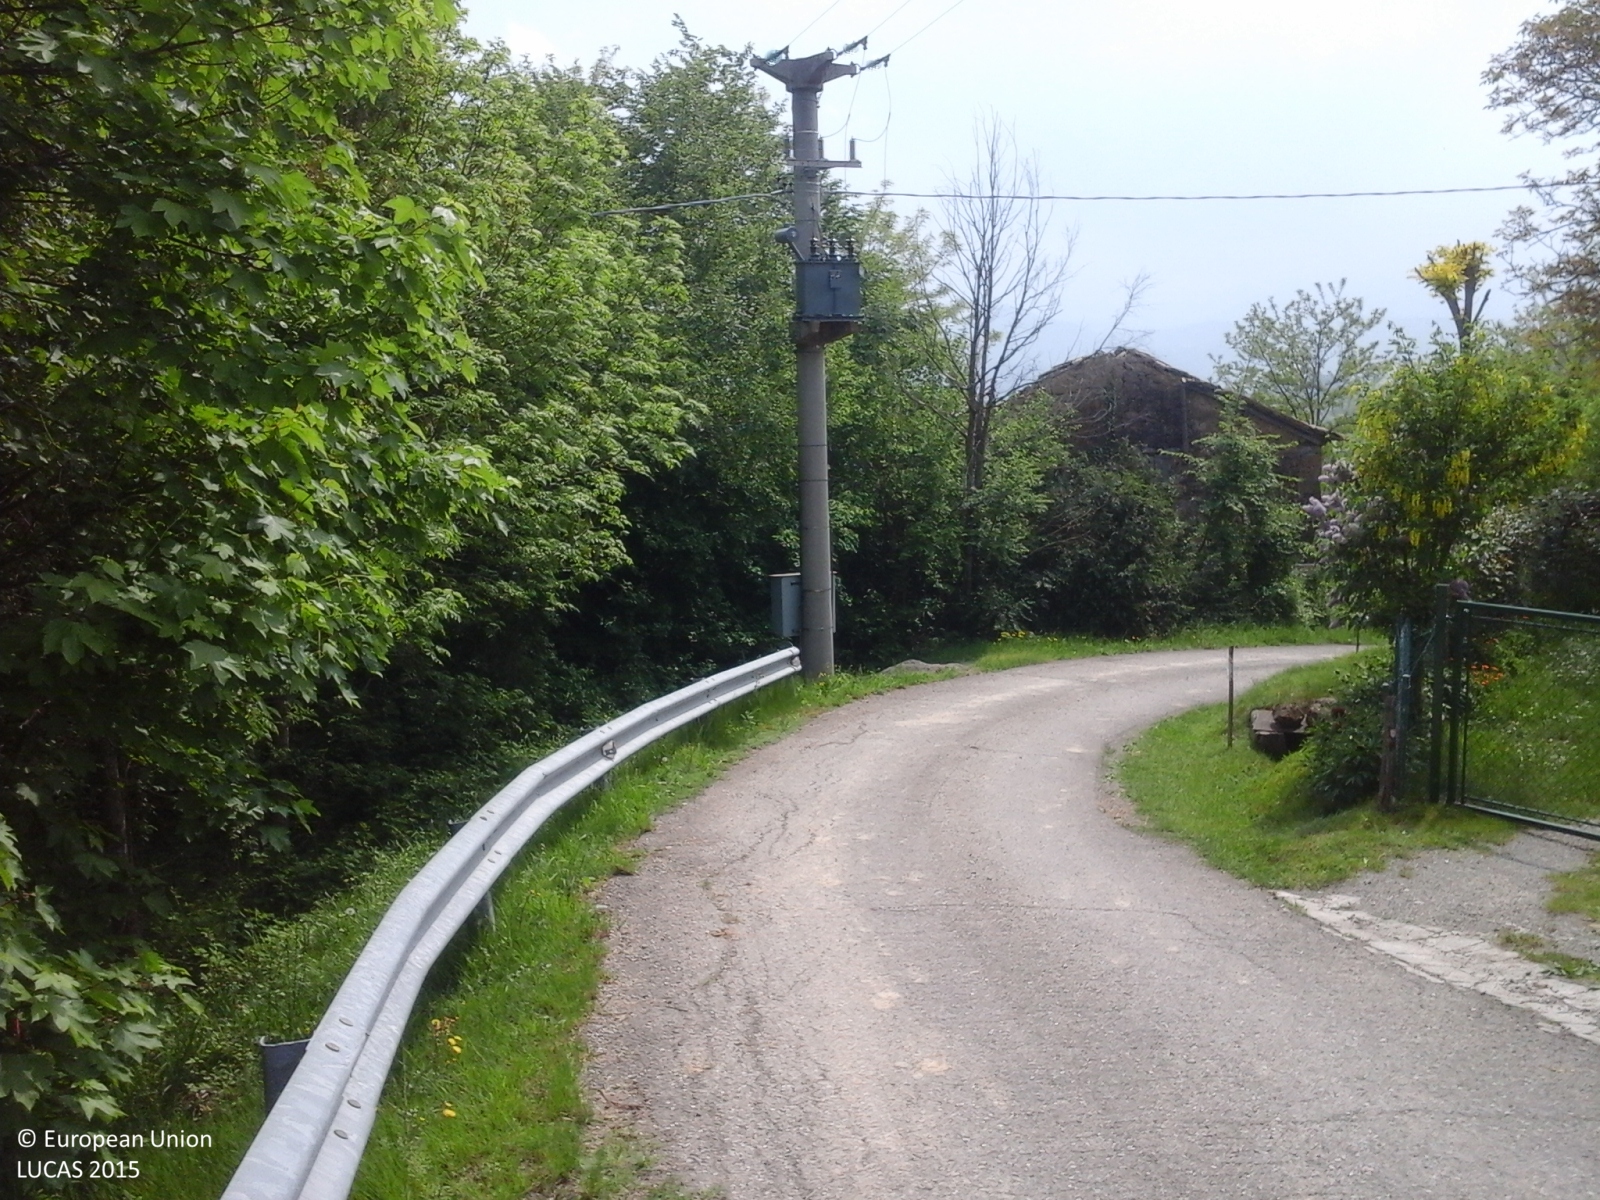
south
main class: Woodland
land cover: Broadleaved woodland
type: mesophytic deciduous forest
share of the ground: > 75 %
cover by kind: broadleaved forest trees 100 %
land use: Forestry
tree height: > 5 m
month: May
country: IT
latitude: 44.3289
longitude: 10.8633
